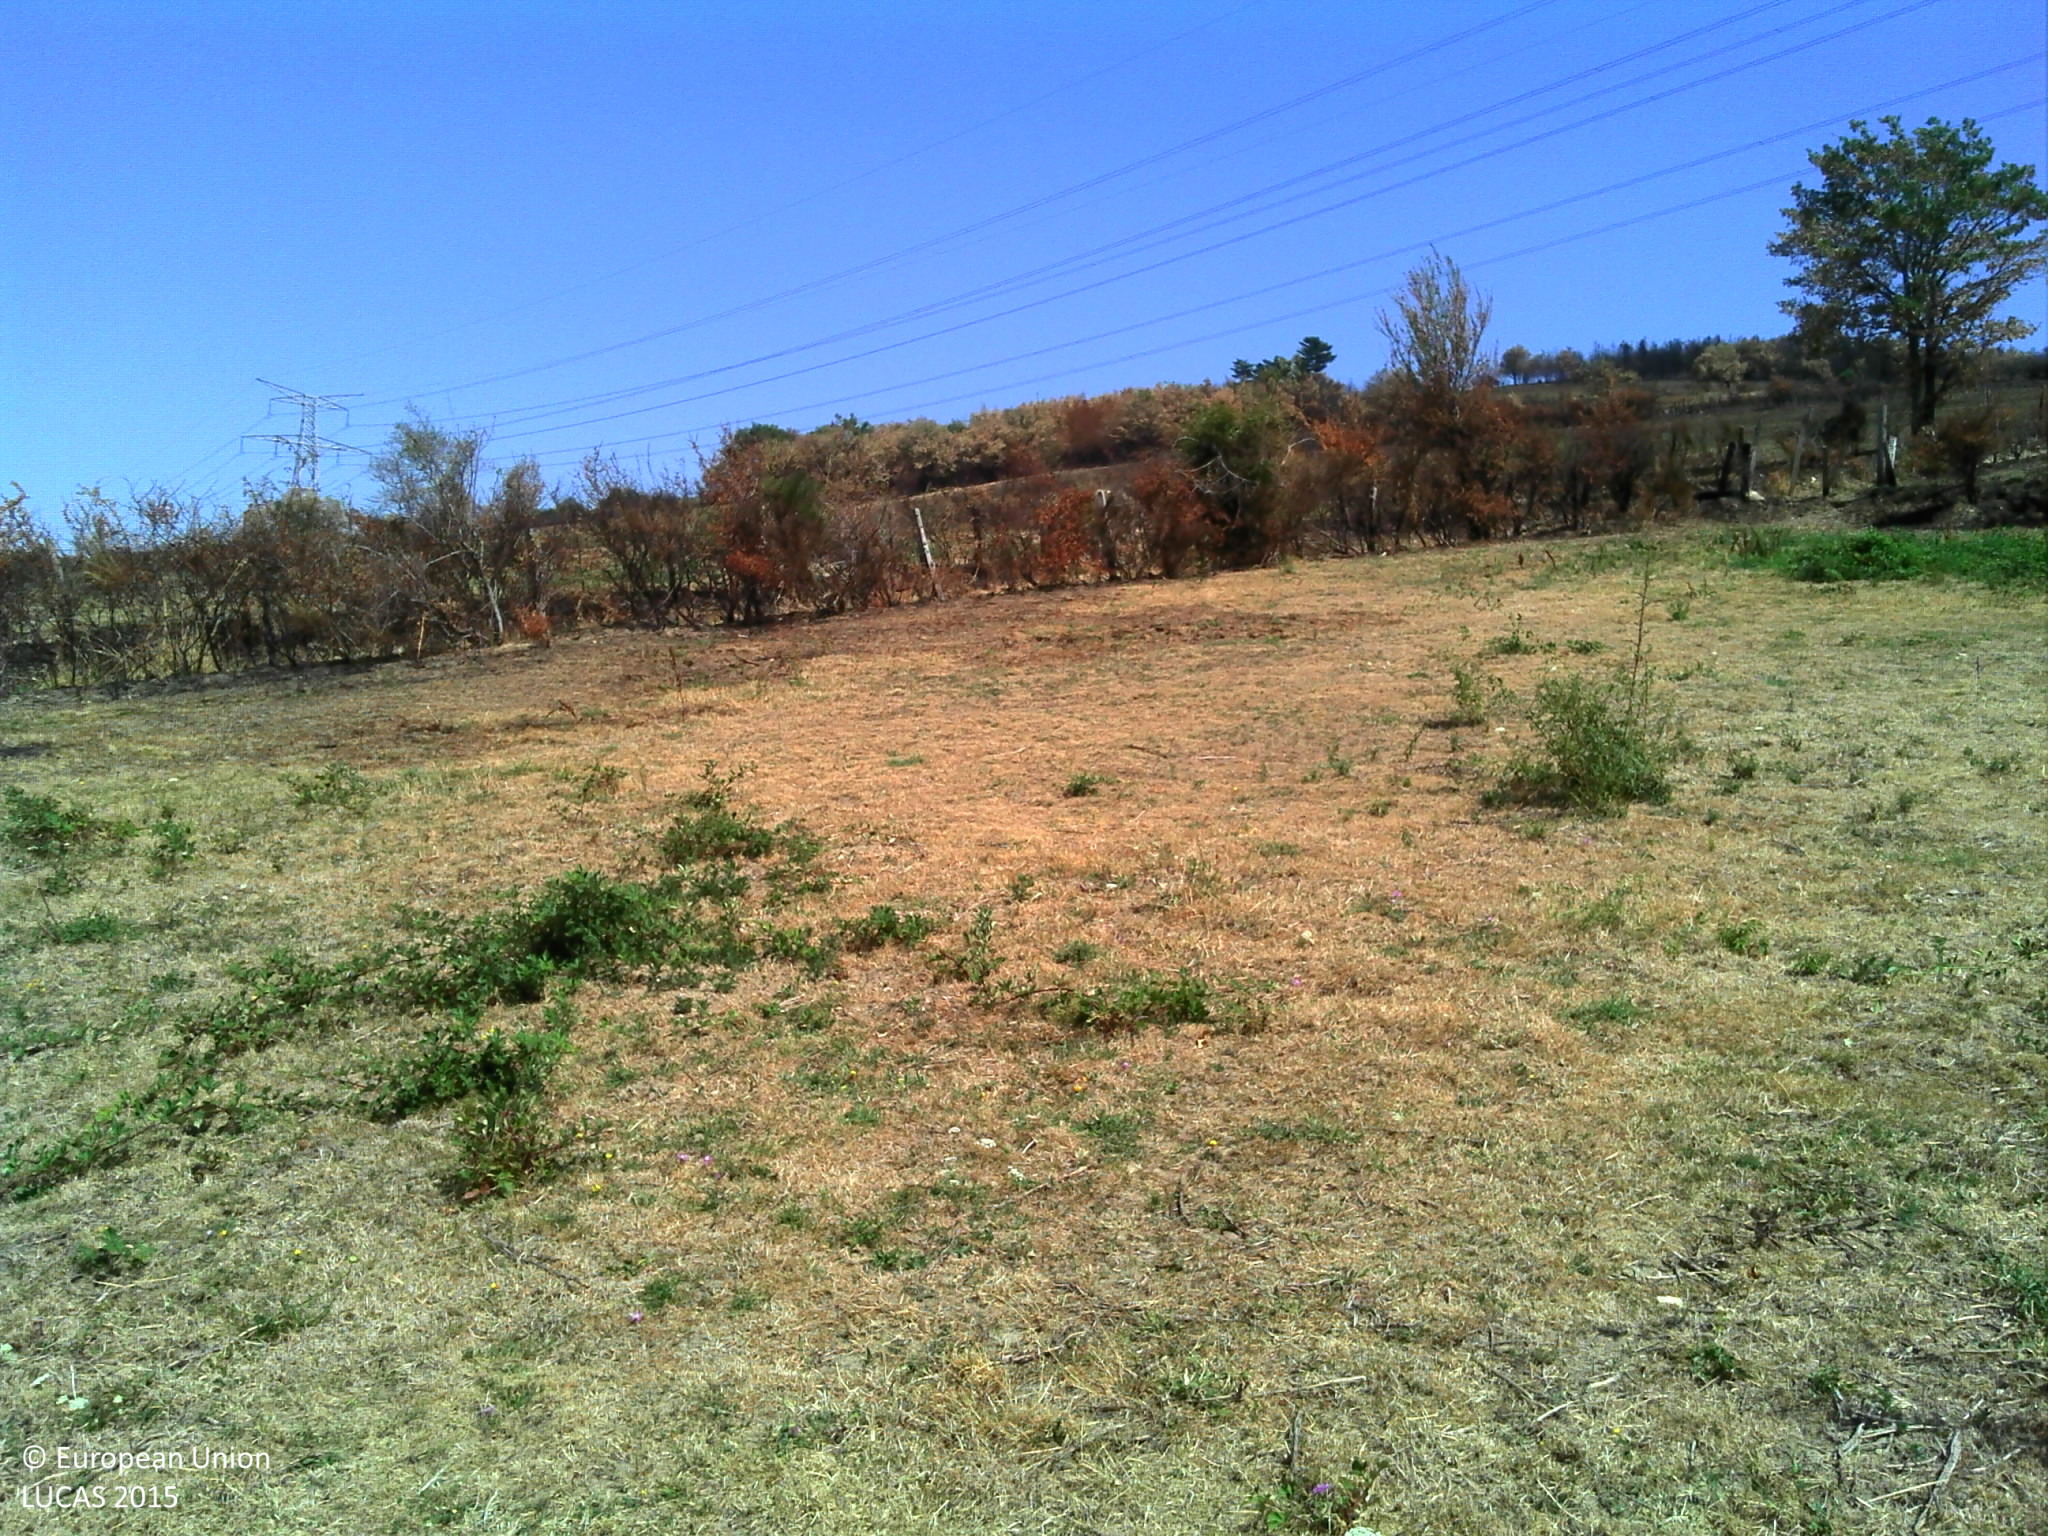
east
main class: Grassland
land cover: Grassland without tree/shrub cover
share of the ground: > 75 %
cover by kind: herbaceous plants 90 %, unconsolidated bare surface 10 %
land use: Agriculture (excluding fallow land and kitchen gardens)
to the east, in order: Grassland without tree/shrub cover; Managed hedges; Fences; Tracks; Fences; Managed hedges; Grassland without tree/shrub cover; Electric lines; Grassland without tree/shrub cover; Fences; Managed hedges
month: August
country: FR
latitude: 45.5128
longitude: 4.6405
